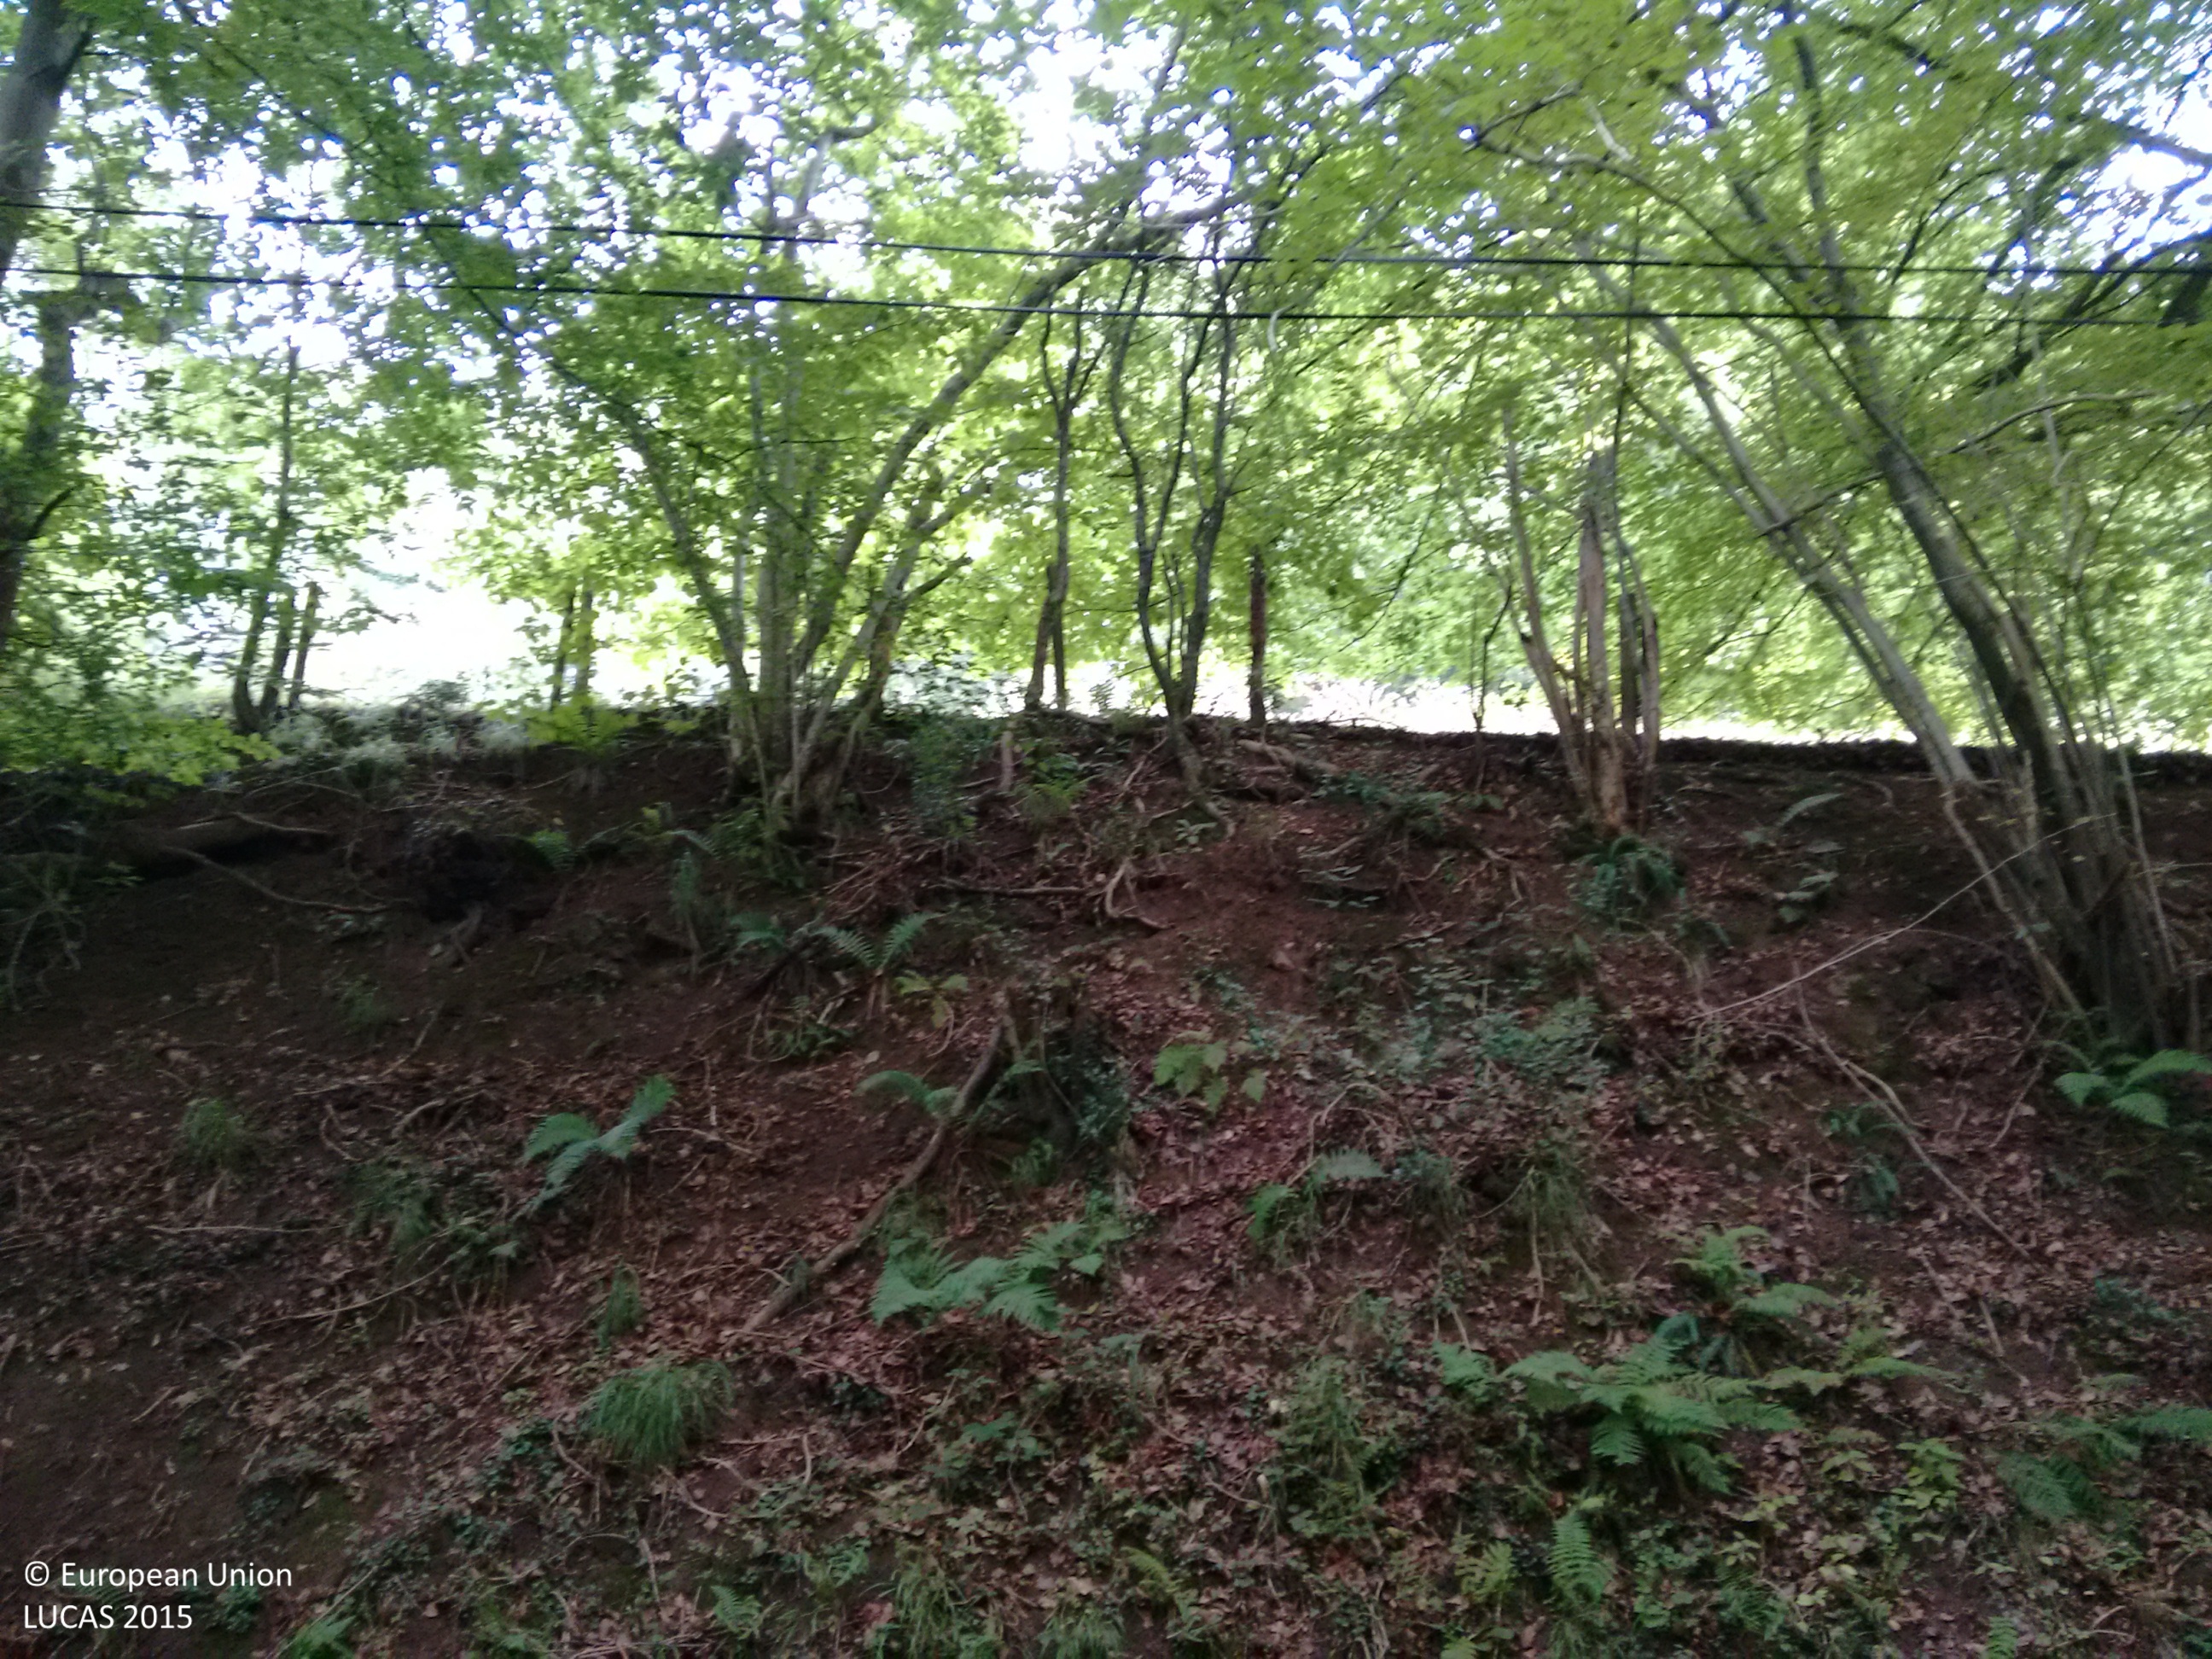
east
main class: Woodland
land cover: Broadleaved woodland
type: mesophytic deciduous forest
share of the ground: > 75 %
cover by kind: broadleaved forest trees 80 %, shrubs 20 %
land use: Semi-natural and natural areas not in use
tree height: > 5 m
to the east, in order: Broadleaved woodland; Rivers and streams; Broadleaved woodland; Fences; Grass margins; Paved roads, cycling and walking lanes; Grass margins; Electric lines; Broadleaved woodland; Managed hedges; Grassland with sparse tree/shrub cover
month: September
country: GB
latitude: 52.0533
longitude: -3.2186
